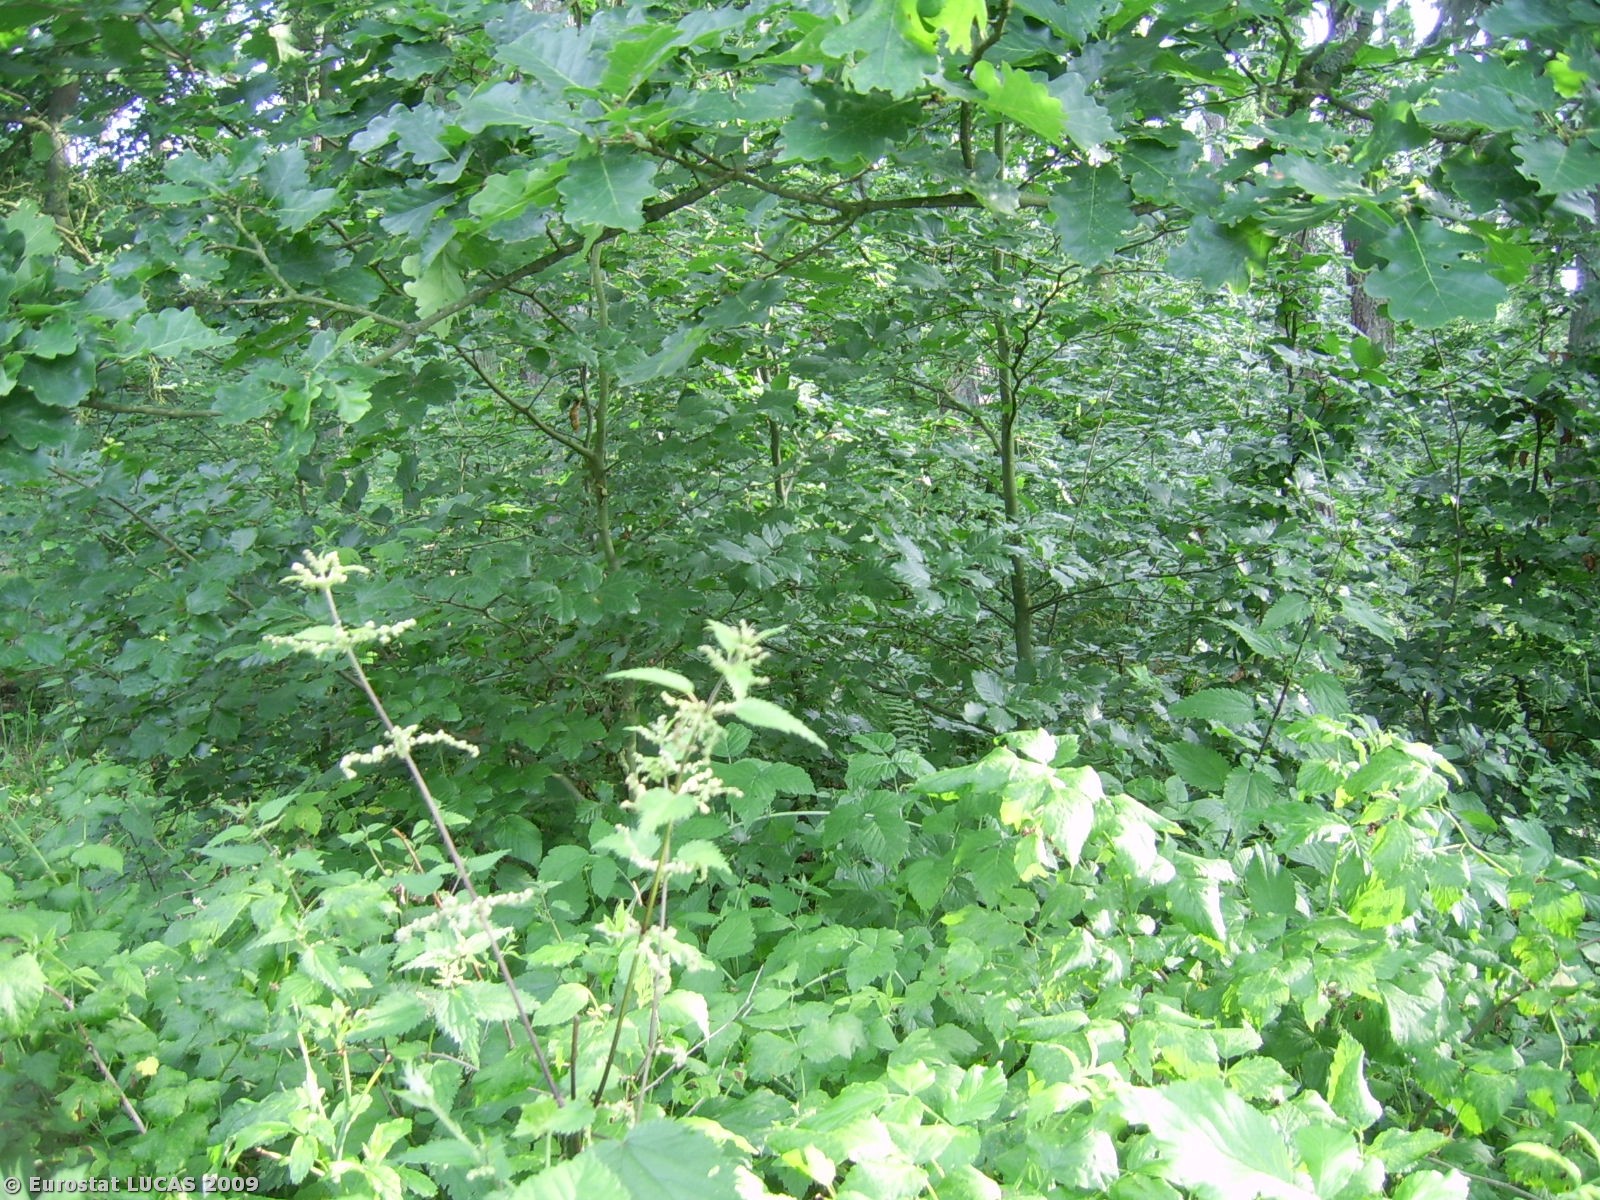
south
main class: Woodland
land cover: Mixed woodland
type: hemiboreal forest and nemoral coniferous forest and mixed broadleaved-coniferous forest
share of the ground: 50 - 75 %
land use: Nature reserves
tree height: > 5 m
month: July
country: PL
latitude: 52.5334
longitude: 18.1096
